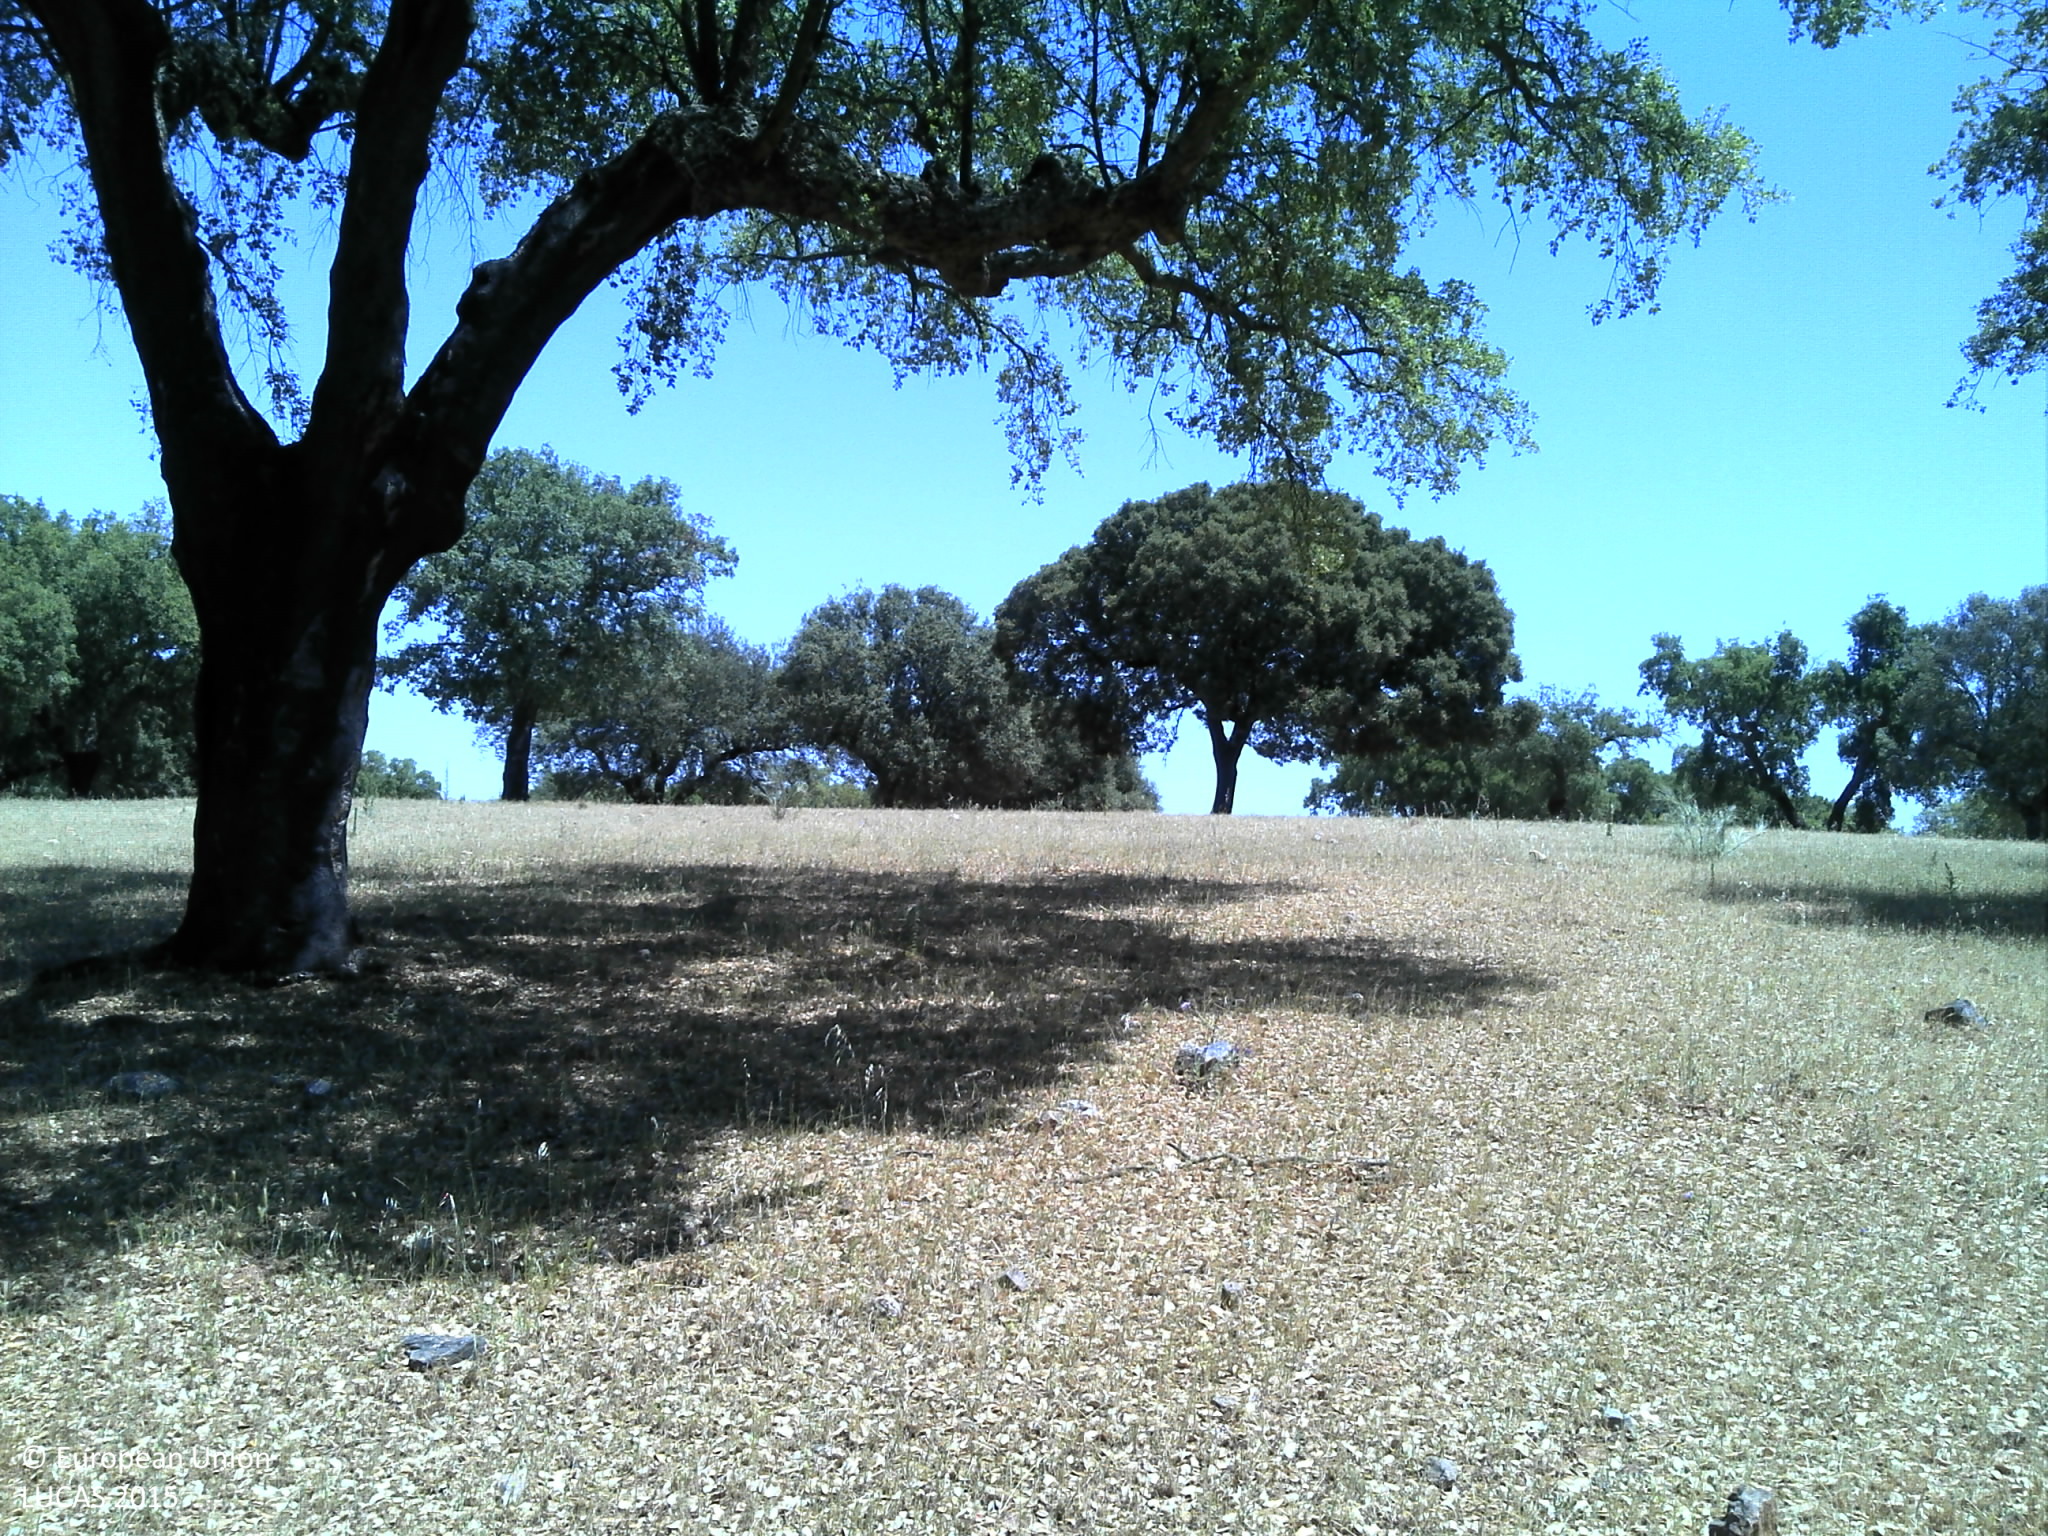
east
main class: Woodland
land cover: Broadleaved woodland
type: broadleaved evergreen forest
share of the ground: 25 - 50 %
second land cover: Grassland without tree/shrub cover
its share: 25 - 50 %
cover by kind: broadleaved forest trees 40 %, unconsolidated bare surface 35 %, herbaceous plants 25 %
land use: Forestry
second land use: Agriculture (excluding fallow land and kitchen gardens)
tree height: > 5 m
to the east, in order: Broadleaved woodland; Grassland without tree/shrub cover; Broadleaved woodland; Grassland without tree/shrub cover
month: May
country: PT
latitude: 38.9550
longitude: -7.6141
